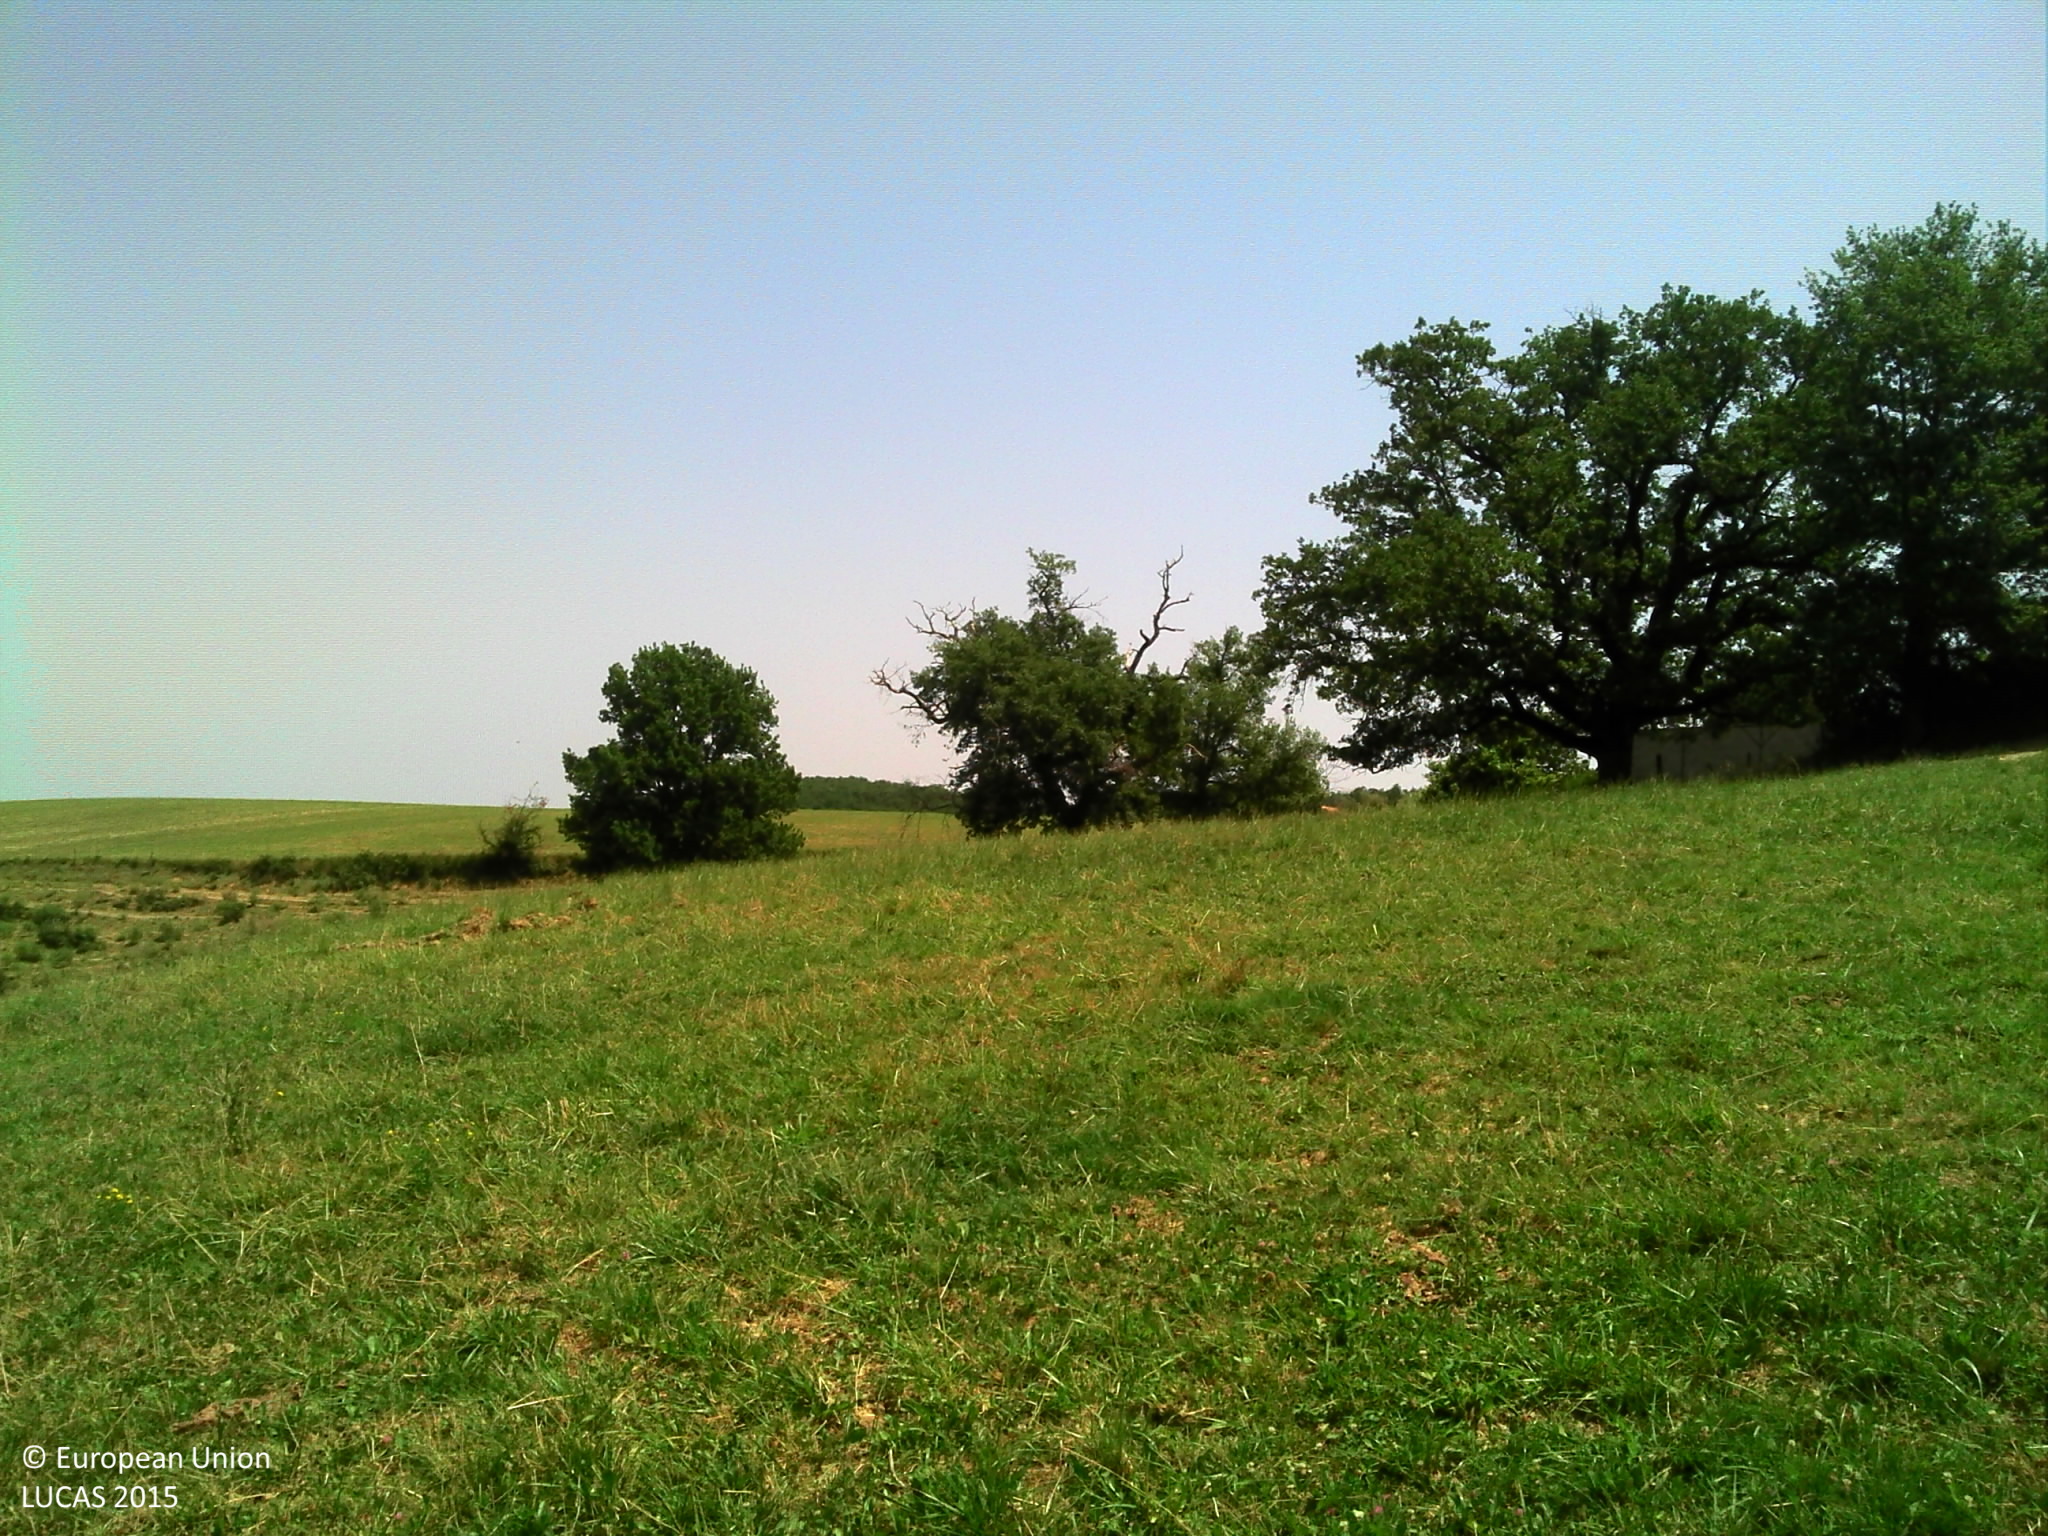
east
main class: Grassland
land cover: Grassland without tree/shrub cover
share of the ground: > 75 %
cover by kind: herbaceous plants 100 %
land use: Agriculture (excluding fallow land and kitchen gardens)
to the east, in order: Grassland without tree/shrub cover; Fences; Single bushes/trees; Other bare soil; Fences; Managed hedges; Grassland without tree/shrub cover
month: July
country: FR
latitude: 43.1236
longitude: 1.4135
